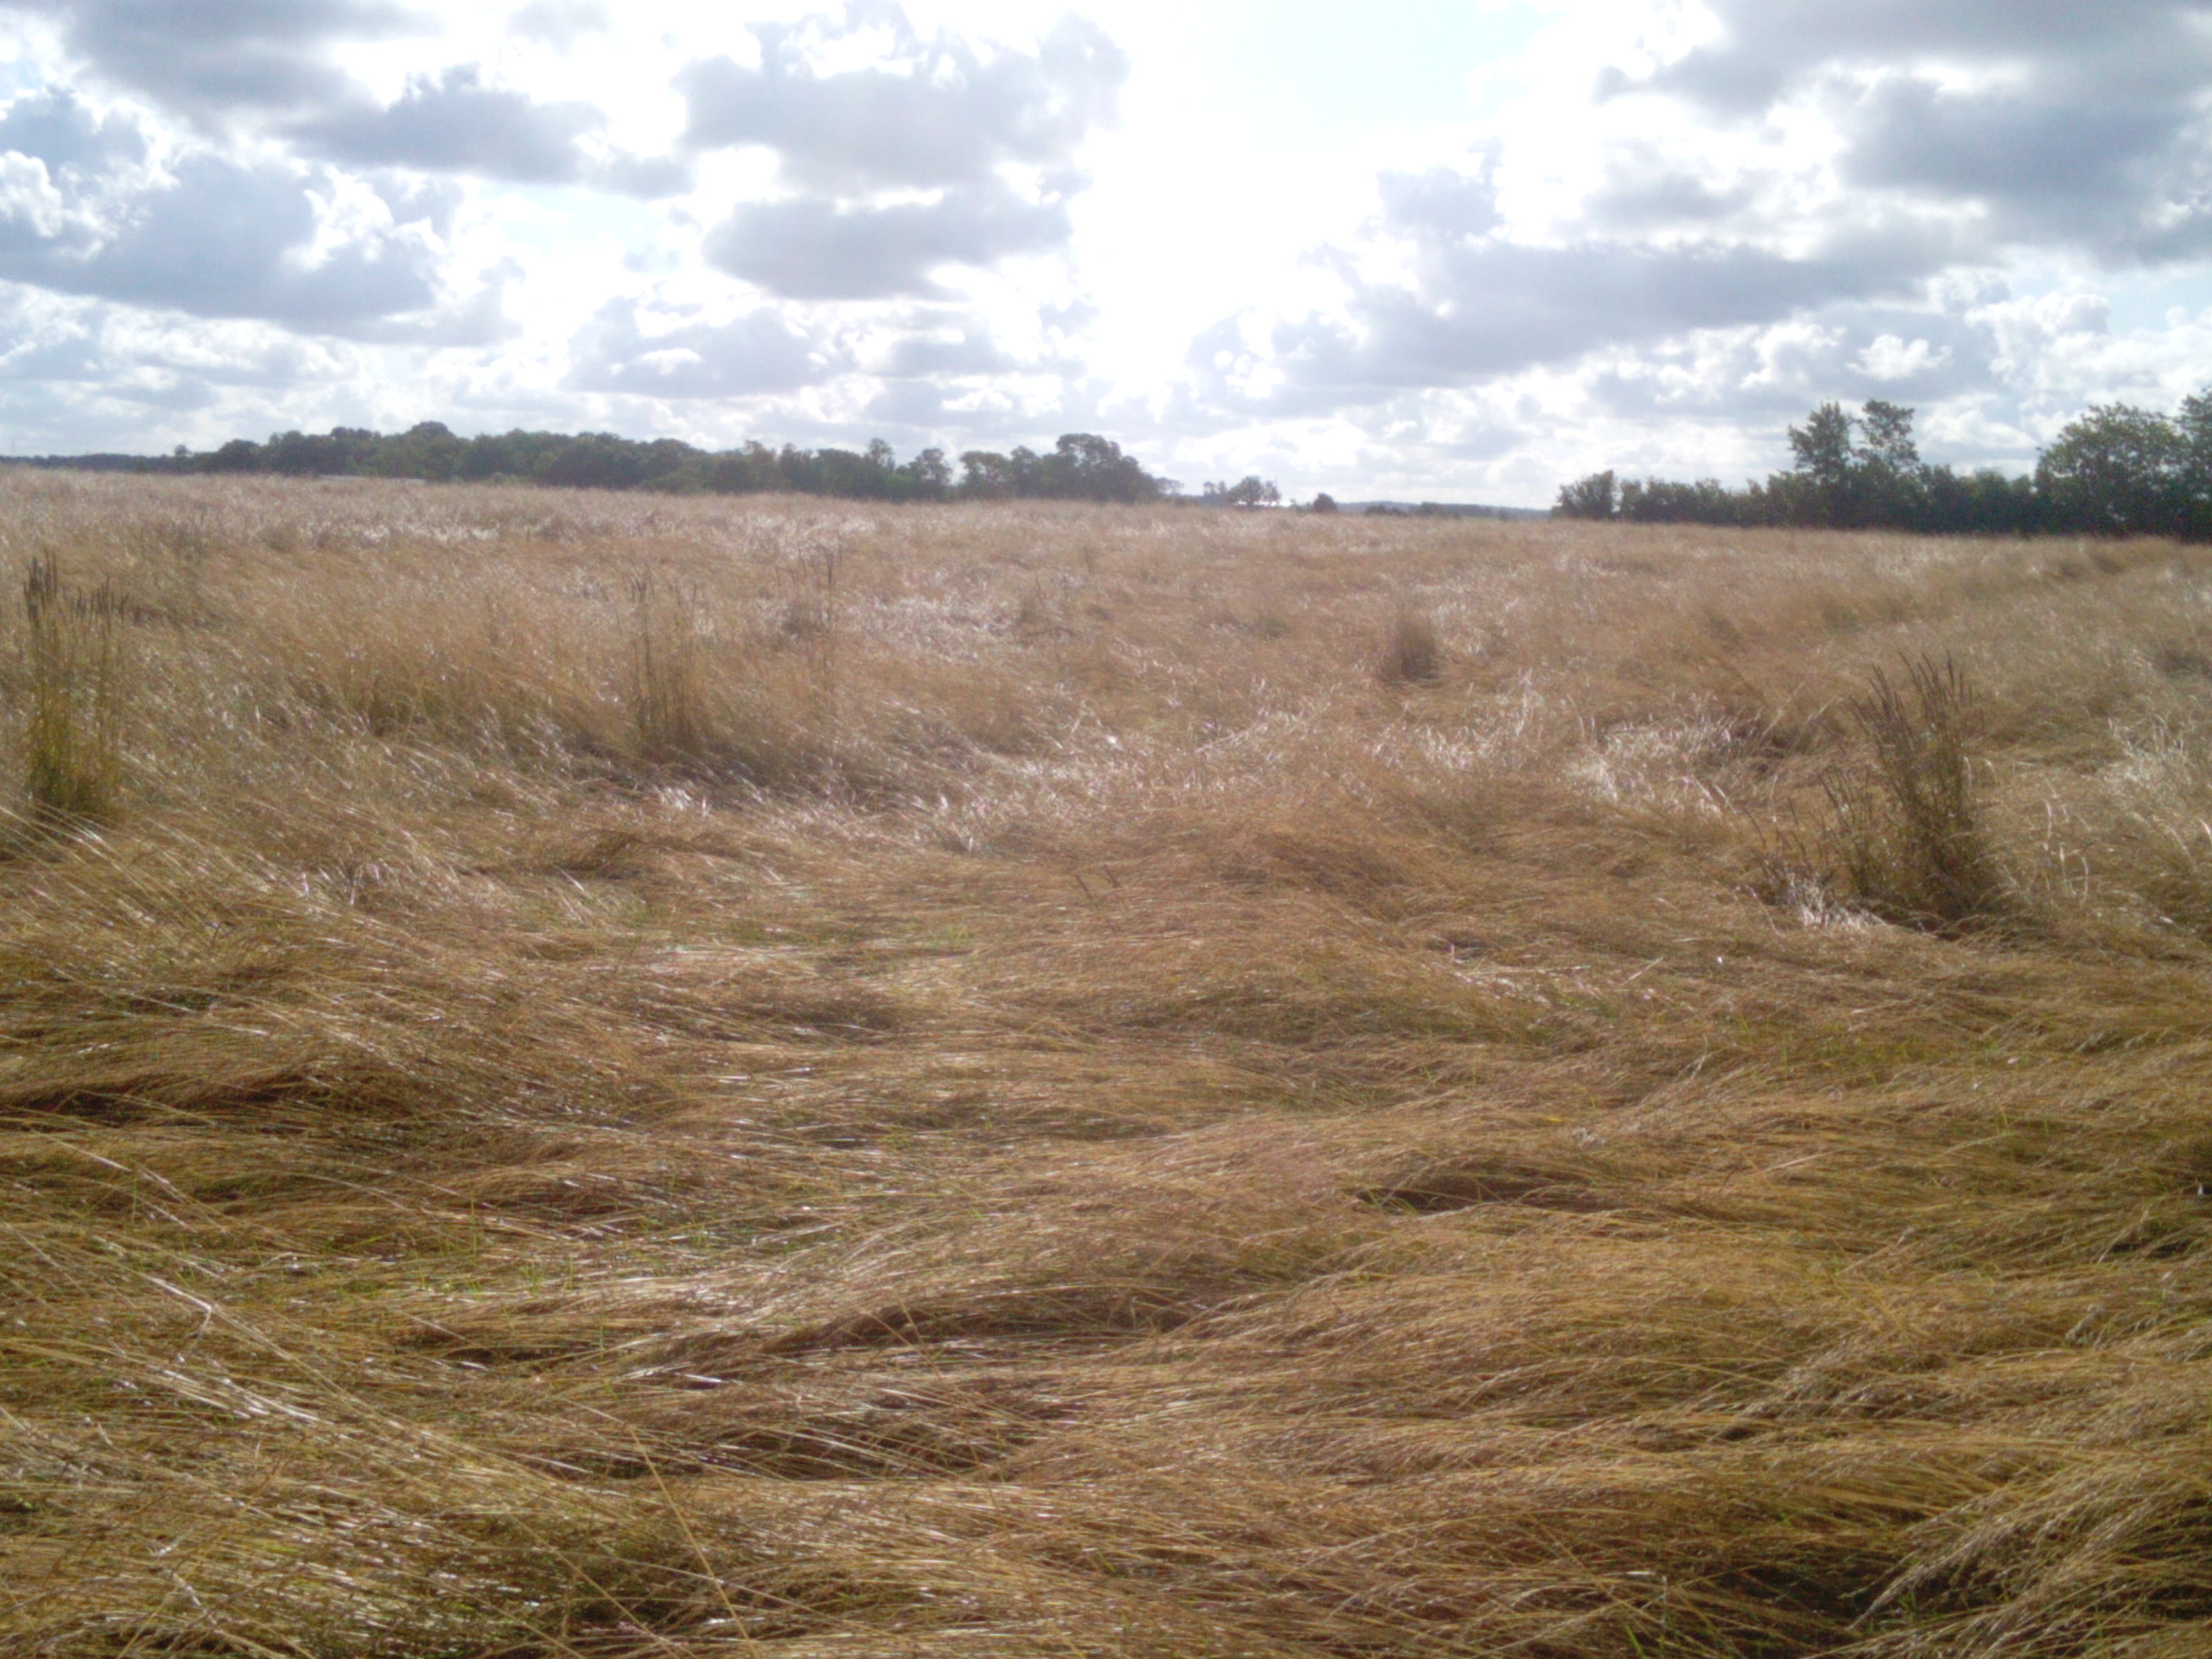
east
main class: Grassland
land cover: Grassland without tree/shrub cover
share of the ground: > 75 %
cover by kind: herbaceous plants 95 %, shrubs 5 %
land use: Agriculture (excluding fallow land and kitchen gardens)
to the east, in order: Grassland without tree/shrub cover
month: July
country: LV
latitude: 56.6848
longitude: 21.3196
